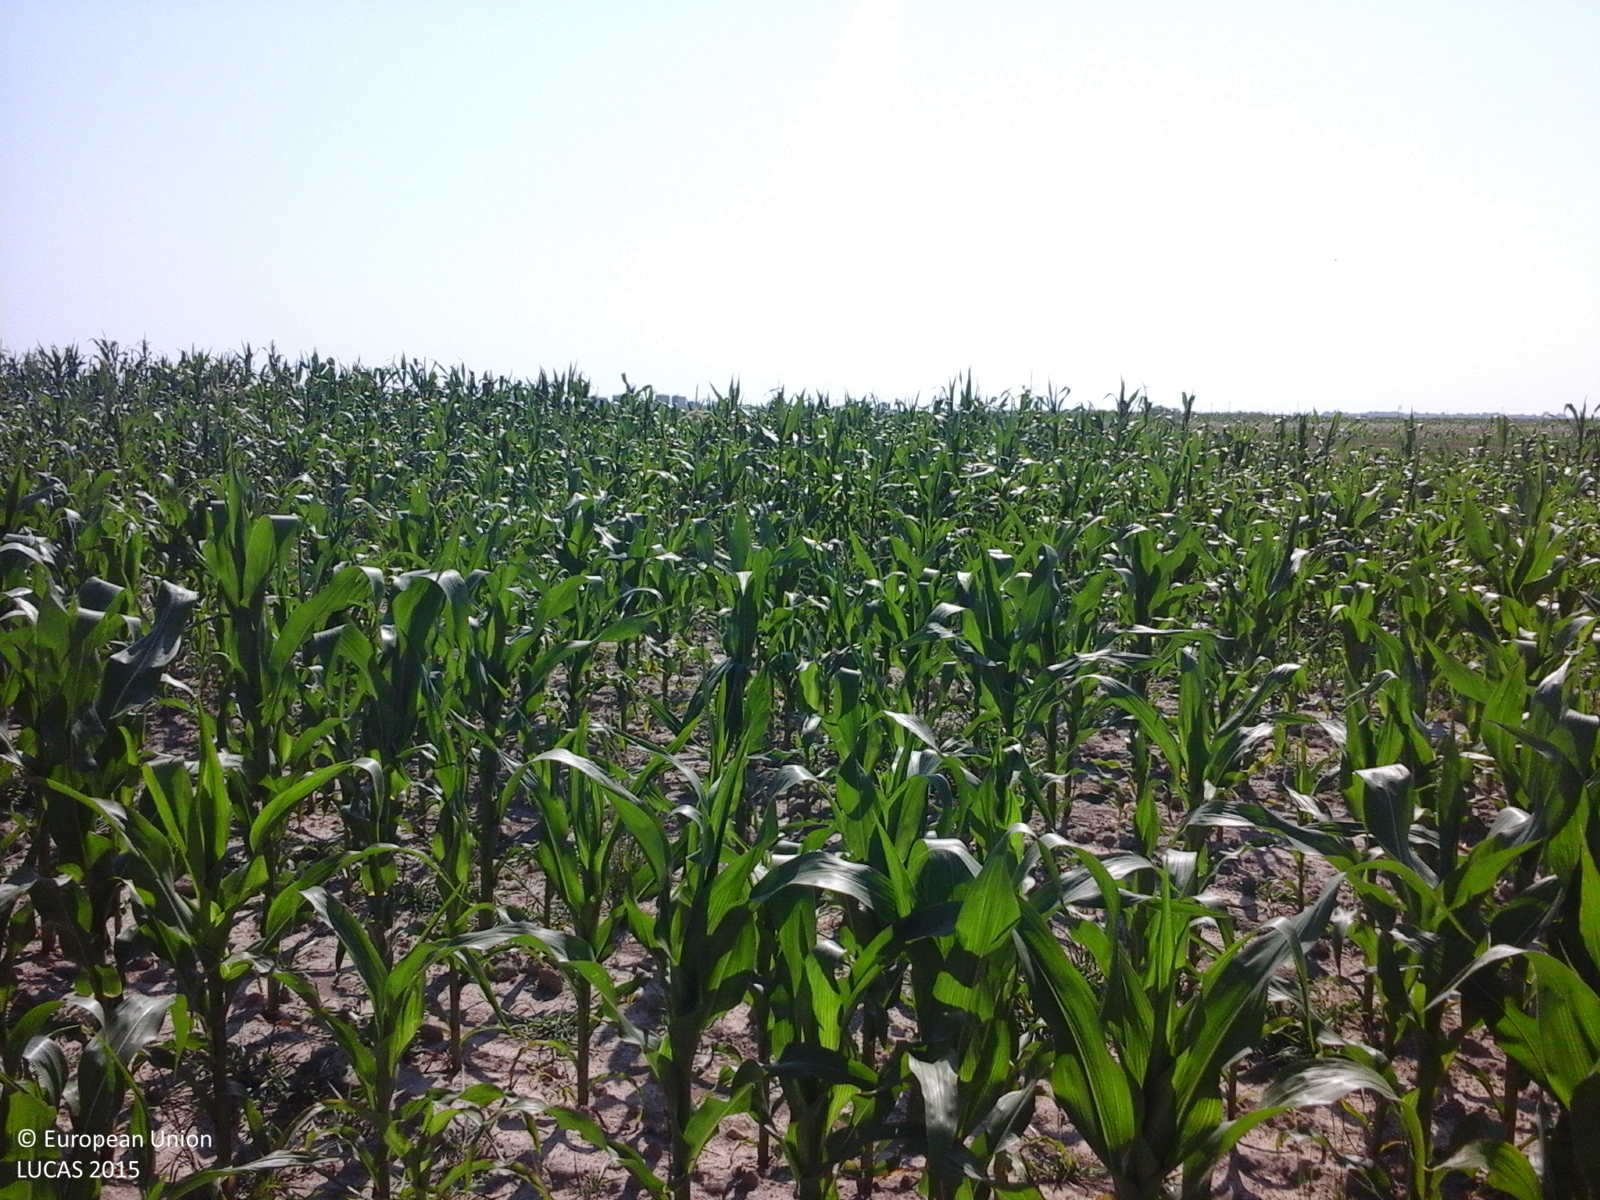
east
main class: Cropland
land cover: Maize
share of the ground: 50 - 75 %
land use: Agriculture (excluding fallow land and kitchen gardens)
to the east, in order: Maize; Other leguminous and mixtures for fodder; Other bare soil; Common wheat; Maize; Mixed cereals for fodder; Grass margins; Maize; Spontaneously vegetated surfaces; Maize; Oats; Maize; Common wheat; Maize; Oats; Other bare soil; Grass margins; Maize
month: July
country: RO
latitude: 44.7547
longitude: 25.0019
